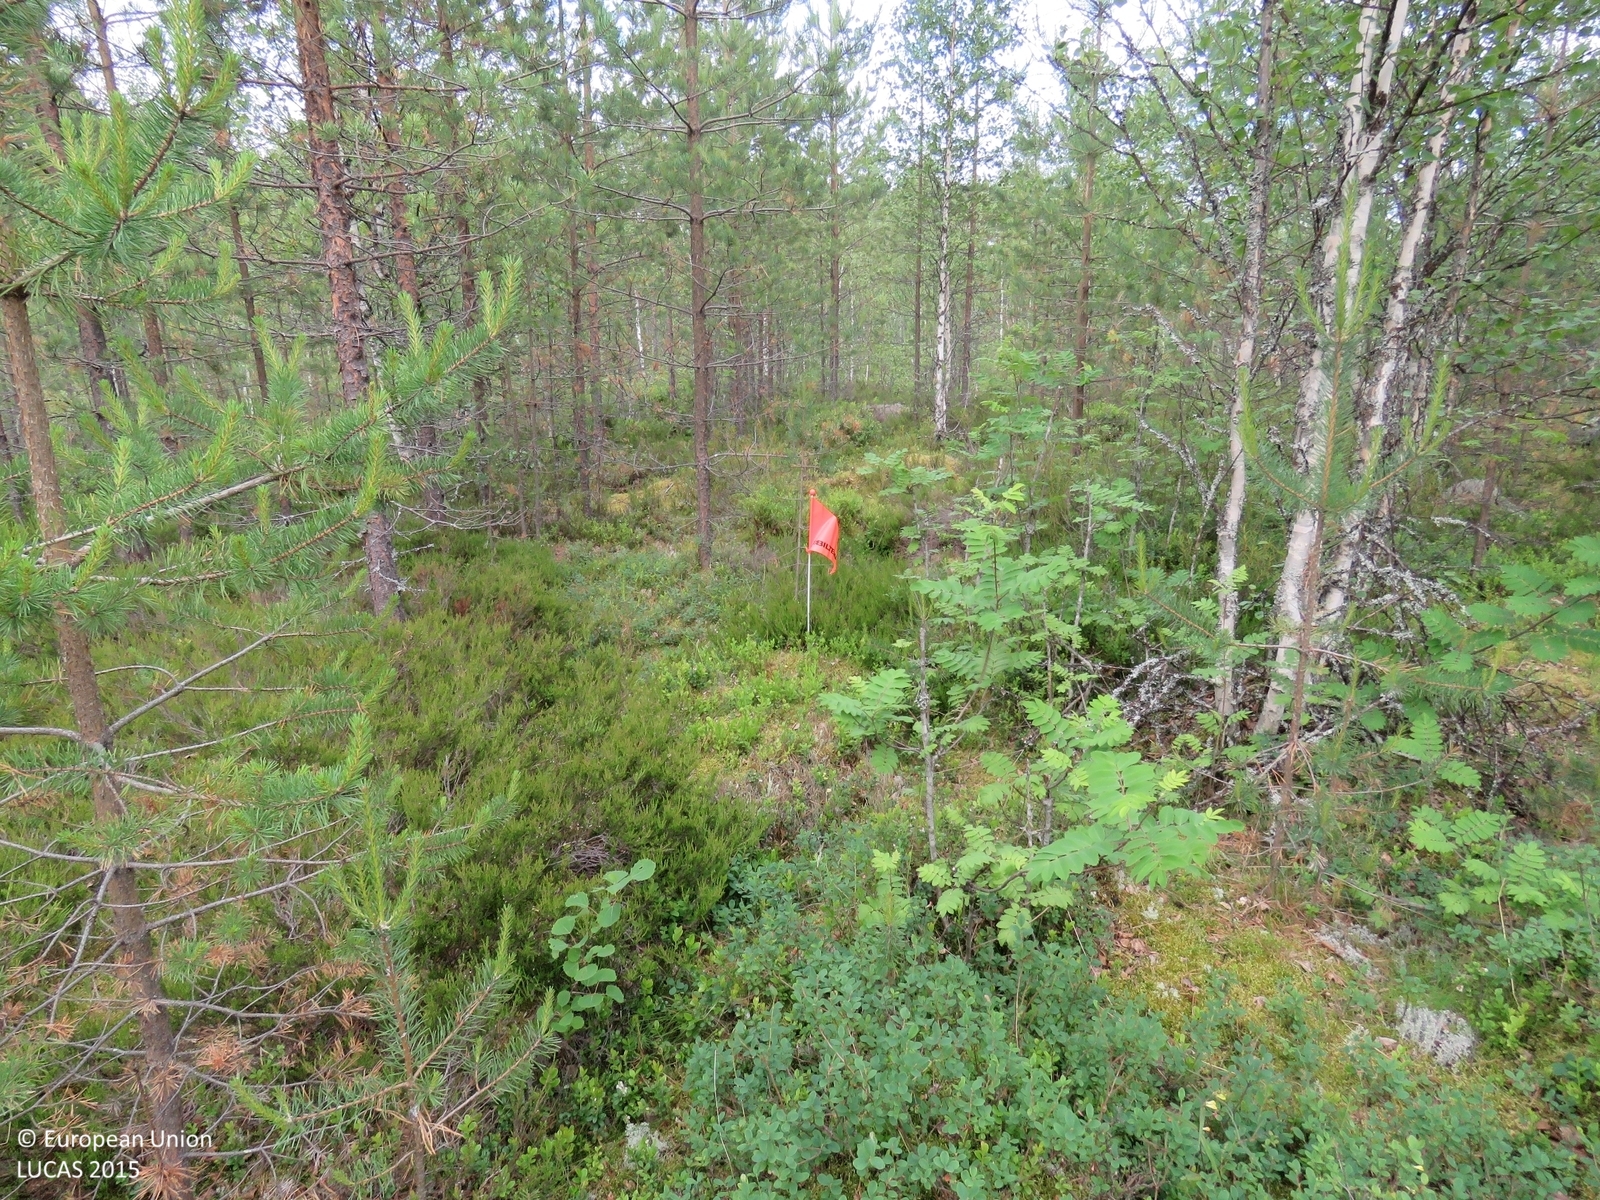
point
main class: Woodland
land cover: Pine dominated mixed woodland
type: boreal forest
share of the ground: > 75 %
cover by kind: coniferous forest trees 45 %, broadleaved forest trees 35 %, shrubs 10 %, herbaceous plants 5 %, lichens and mosses 5 %
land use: Forestry
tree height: > 5 m
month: July
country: FI
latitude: 64.4813
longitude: 26.4019
